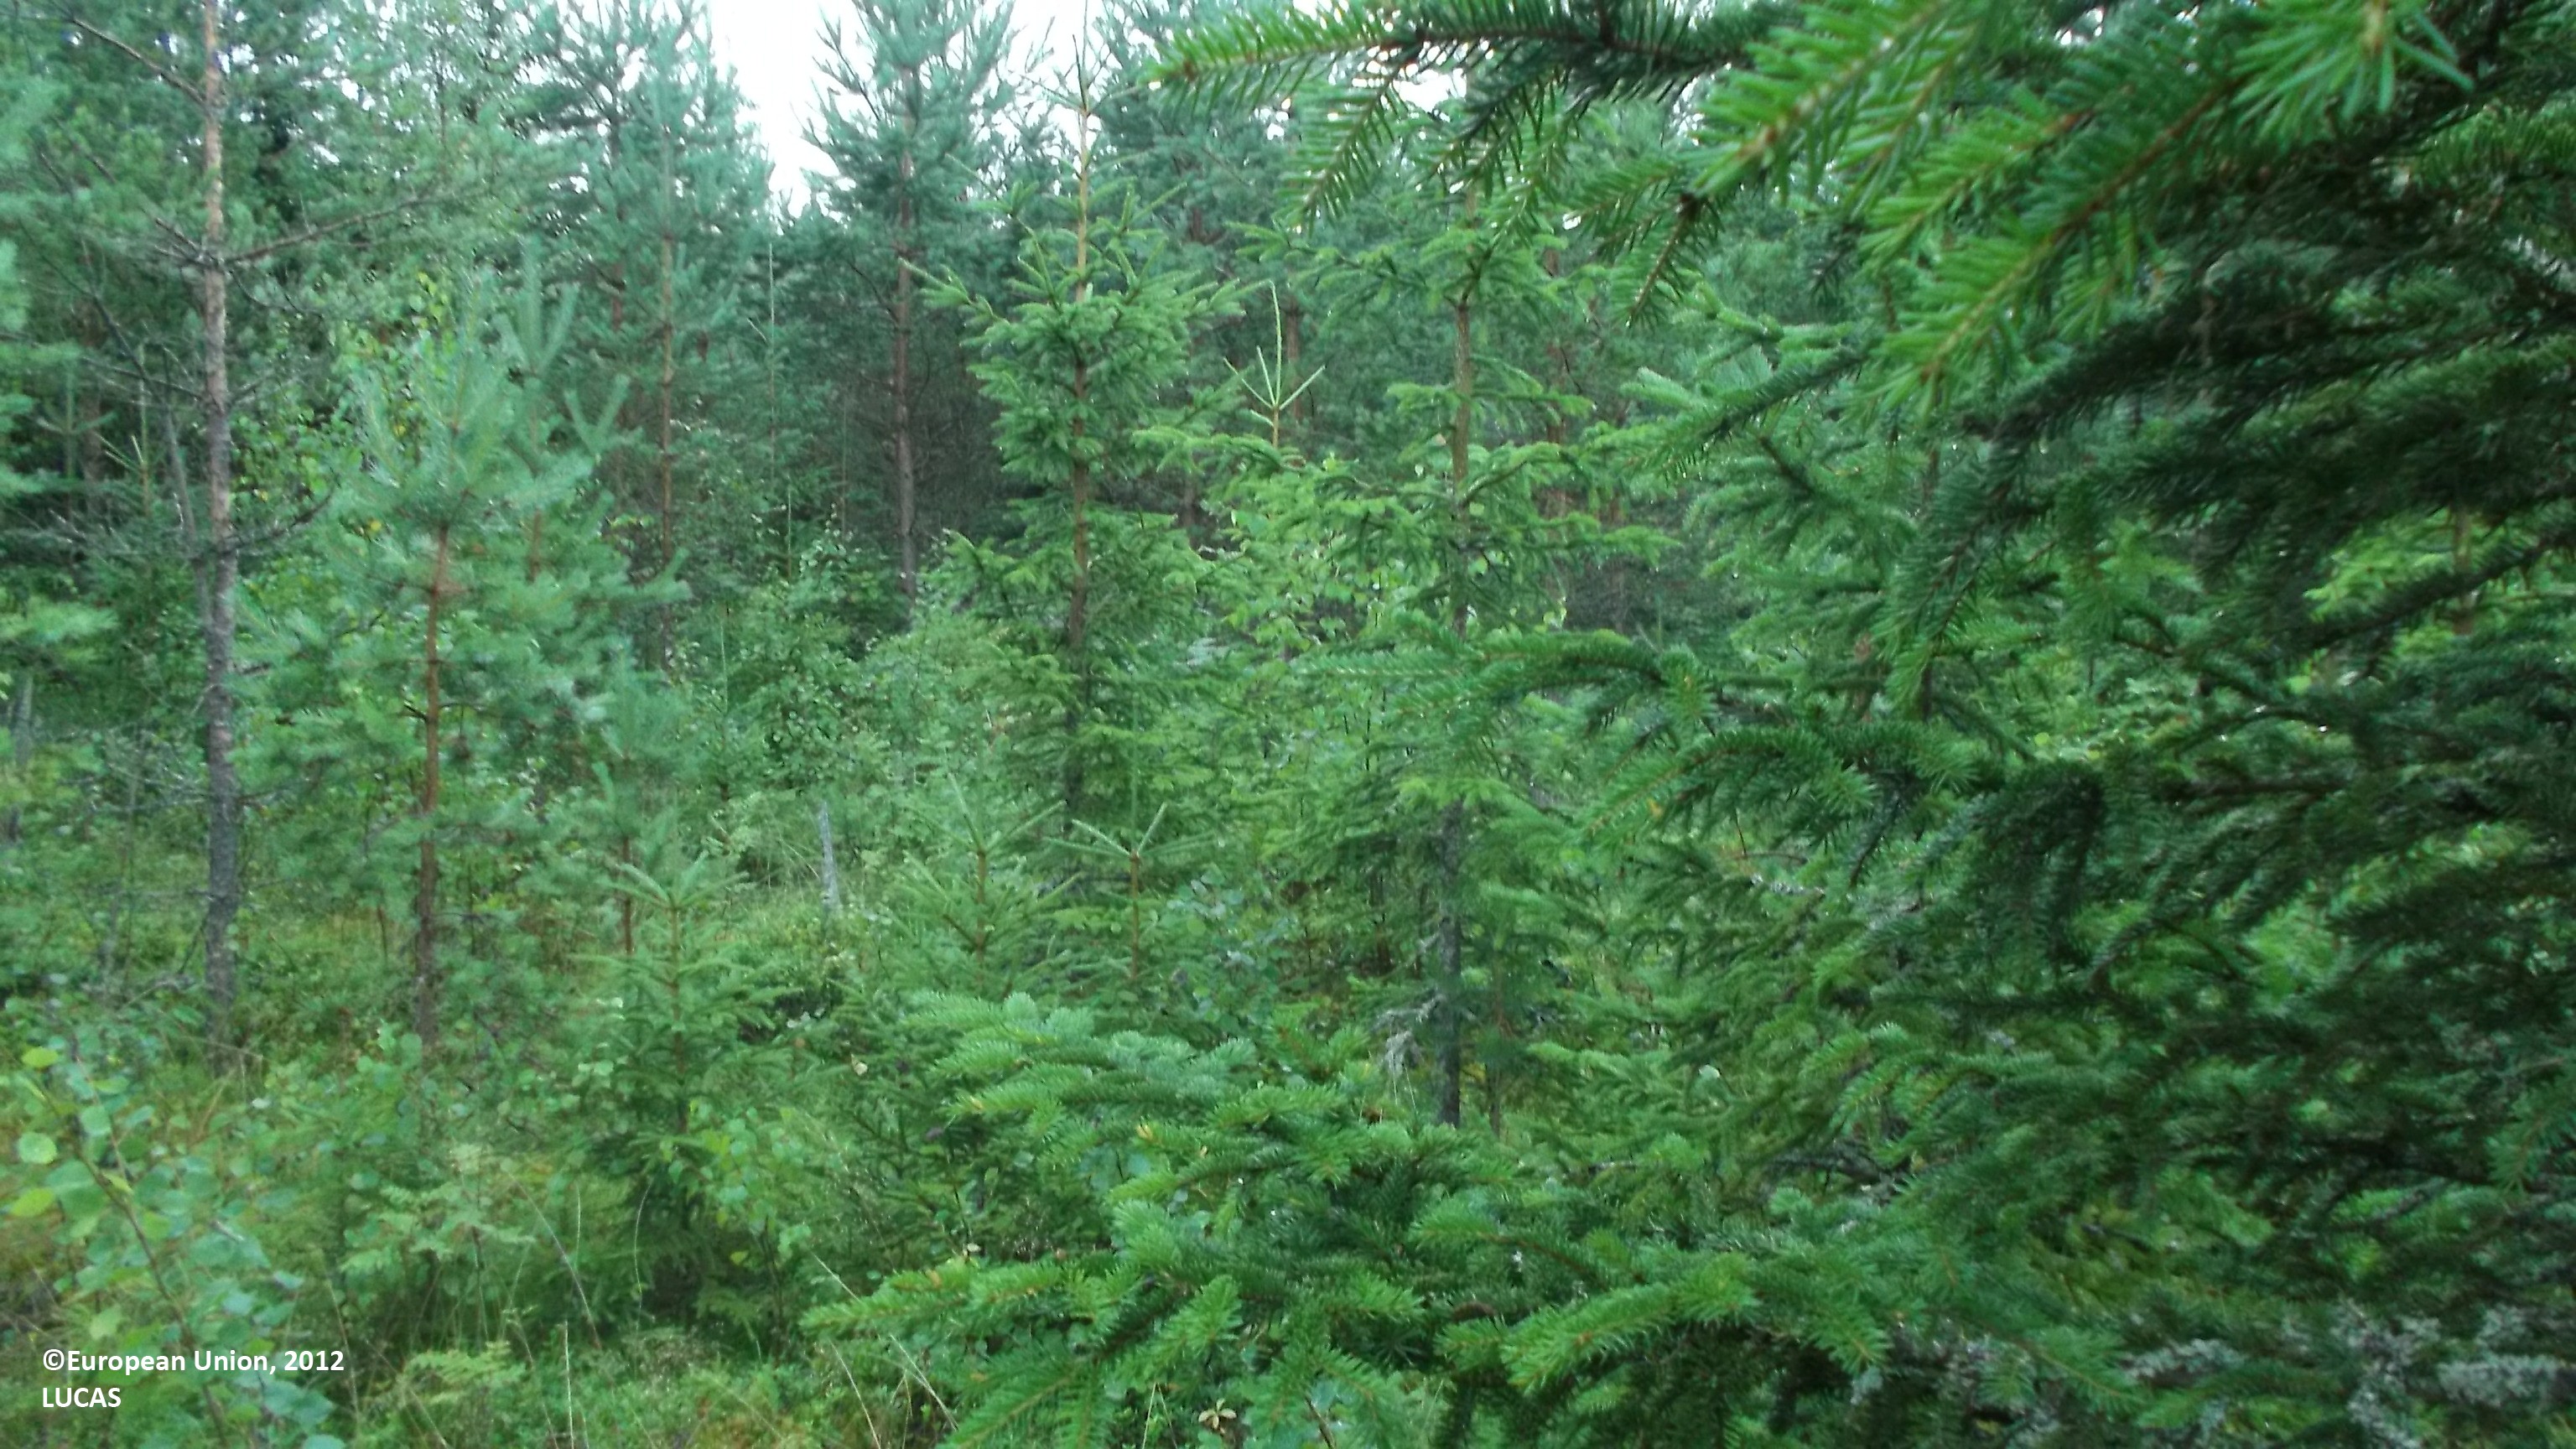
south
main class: Woodland
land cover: Other mixed woodland
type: boreal forest
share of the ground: 50 - 75 %
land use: Forestry
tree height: > 5 m
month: August
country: FI
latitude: 63.7362
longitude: 22.9539
